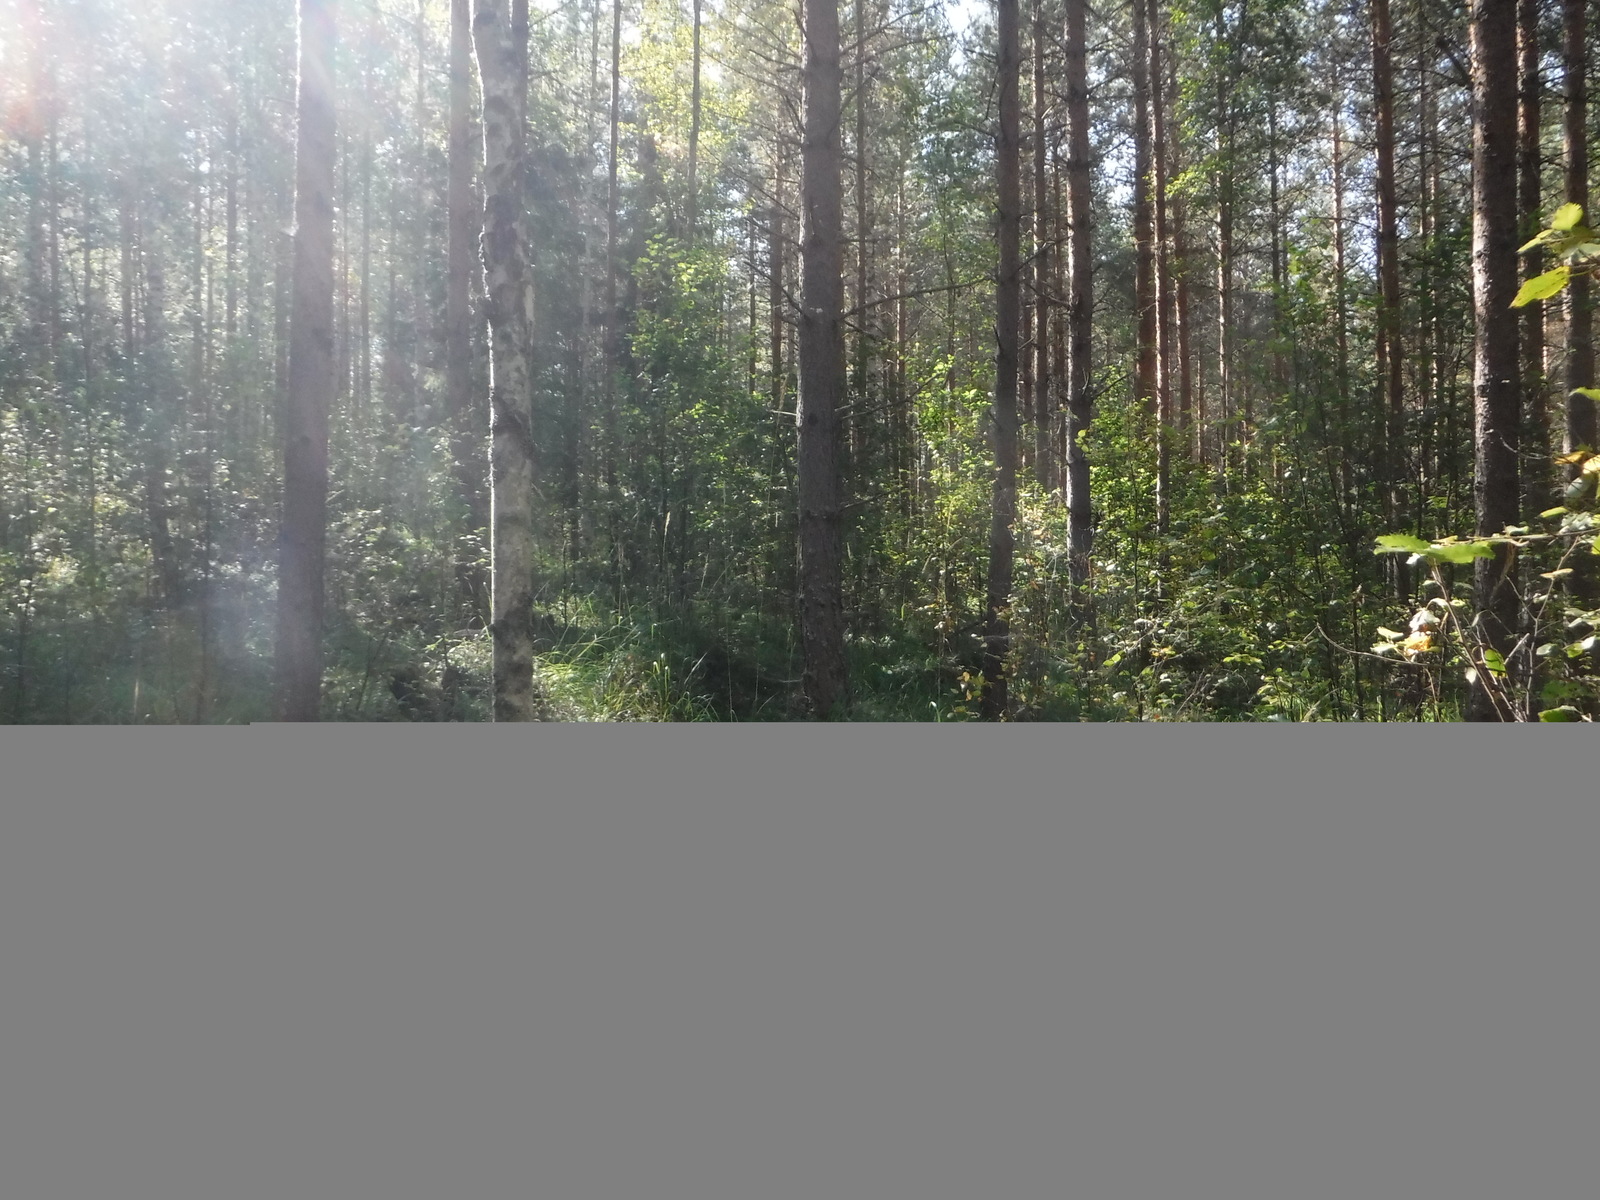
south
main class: Woodland
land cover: Pine dominated mixed woodland
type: boreal forest
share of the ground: 50 - 75 %
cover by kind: coniferous forest trees 40 %, broadleaved forest trees 30 %, herbaceous plants 25 %, shrubs 5 %
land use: Forestry
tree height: > 5 m
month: August
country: FI
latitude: 61.1984
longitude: 22.8539
